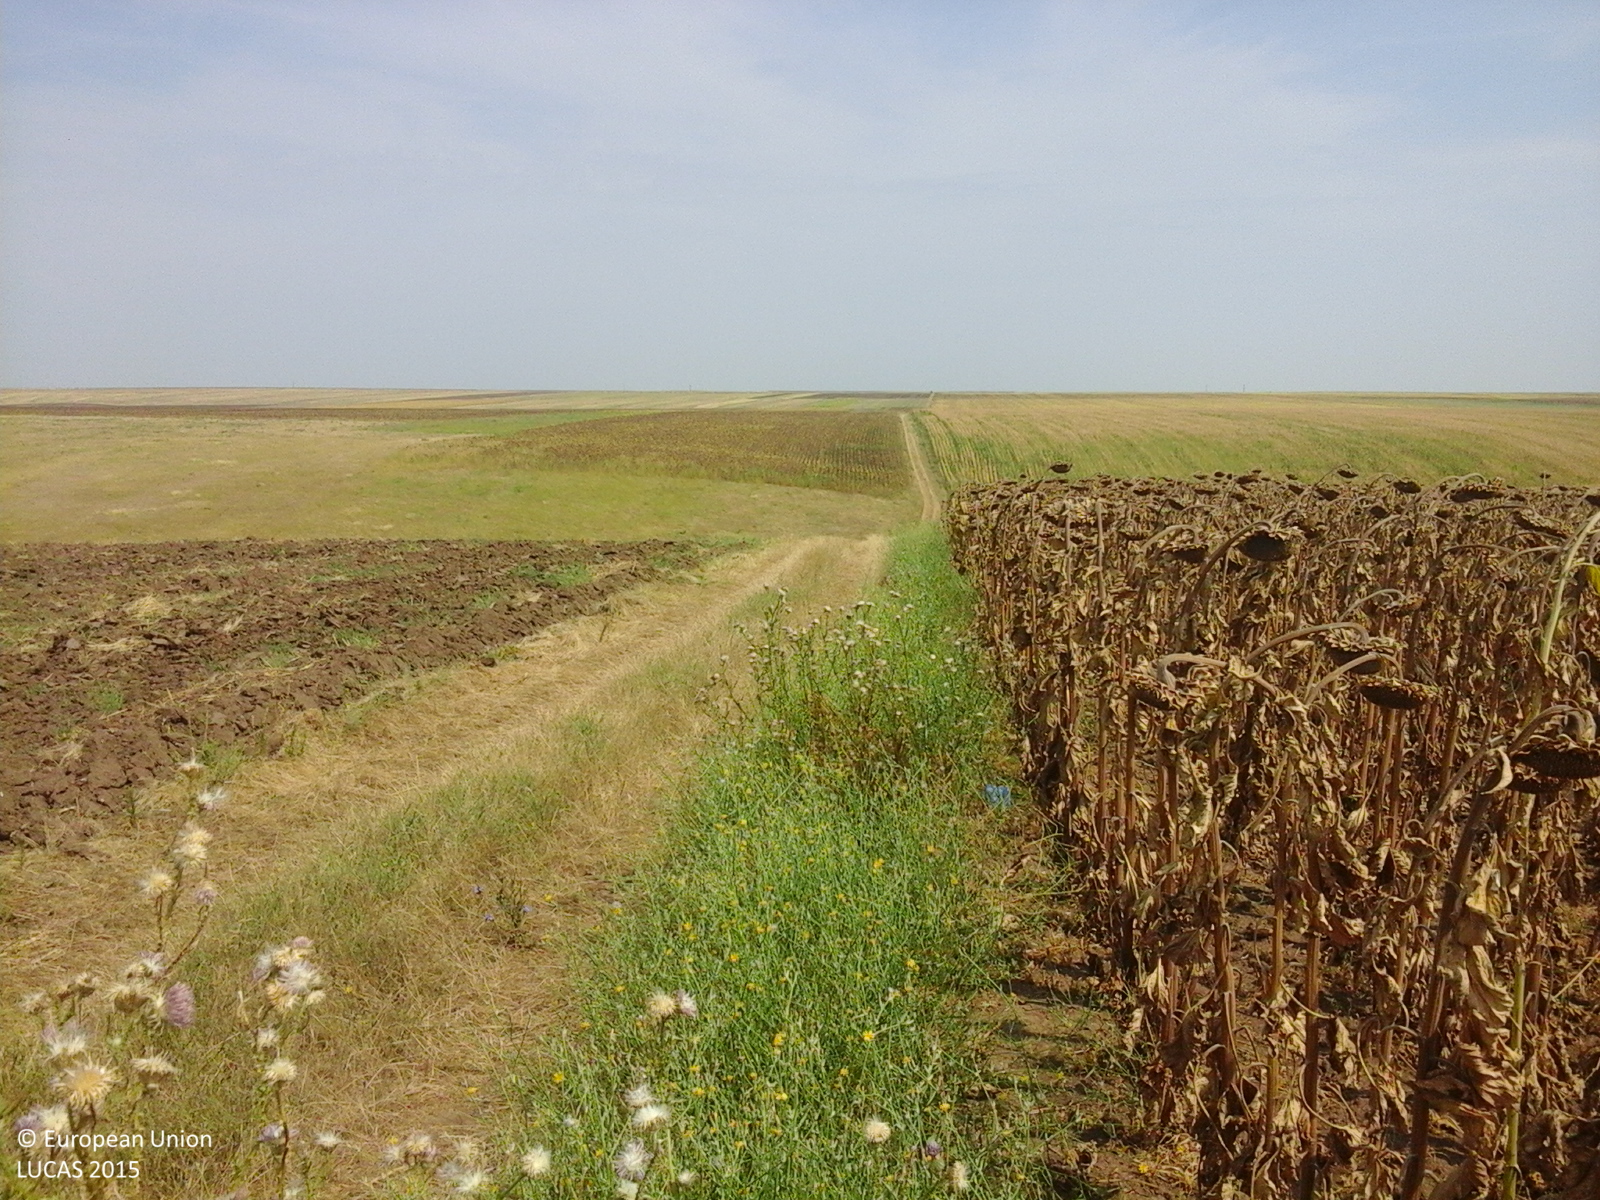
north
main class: Cropland
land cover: Sunflower
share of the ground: > 75 %
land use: Agriculture (excluding fallow land and kitchen gardens)
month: August
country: RO
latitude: 44.1523
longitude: 23.2622
